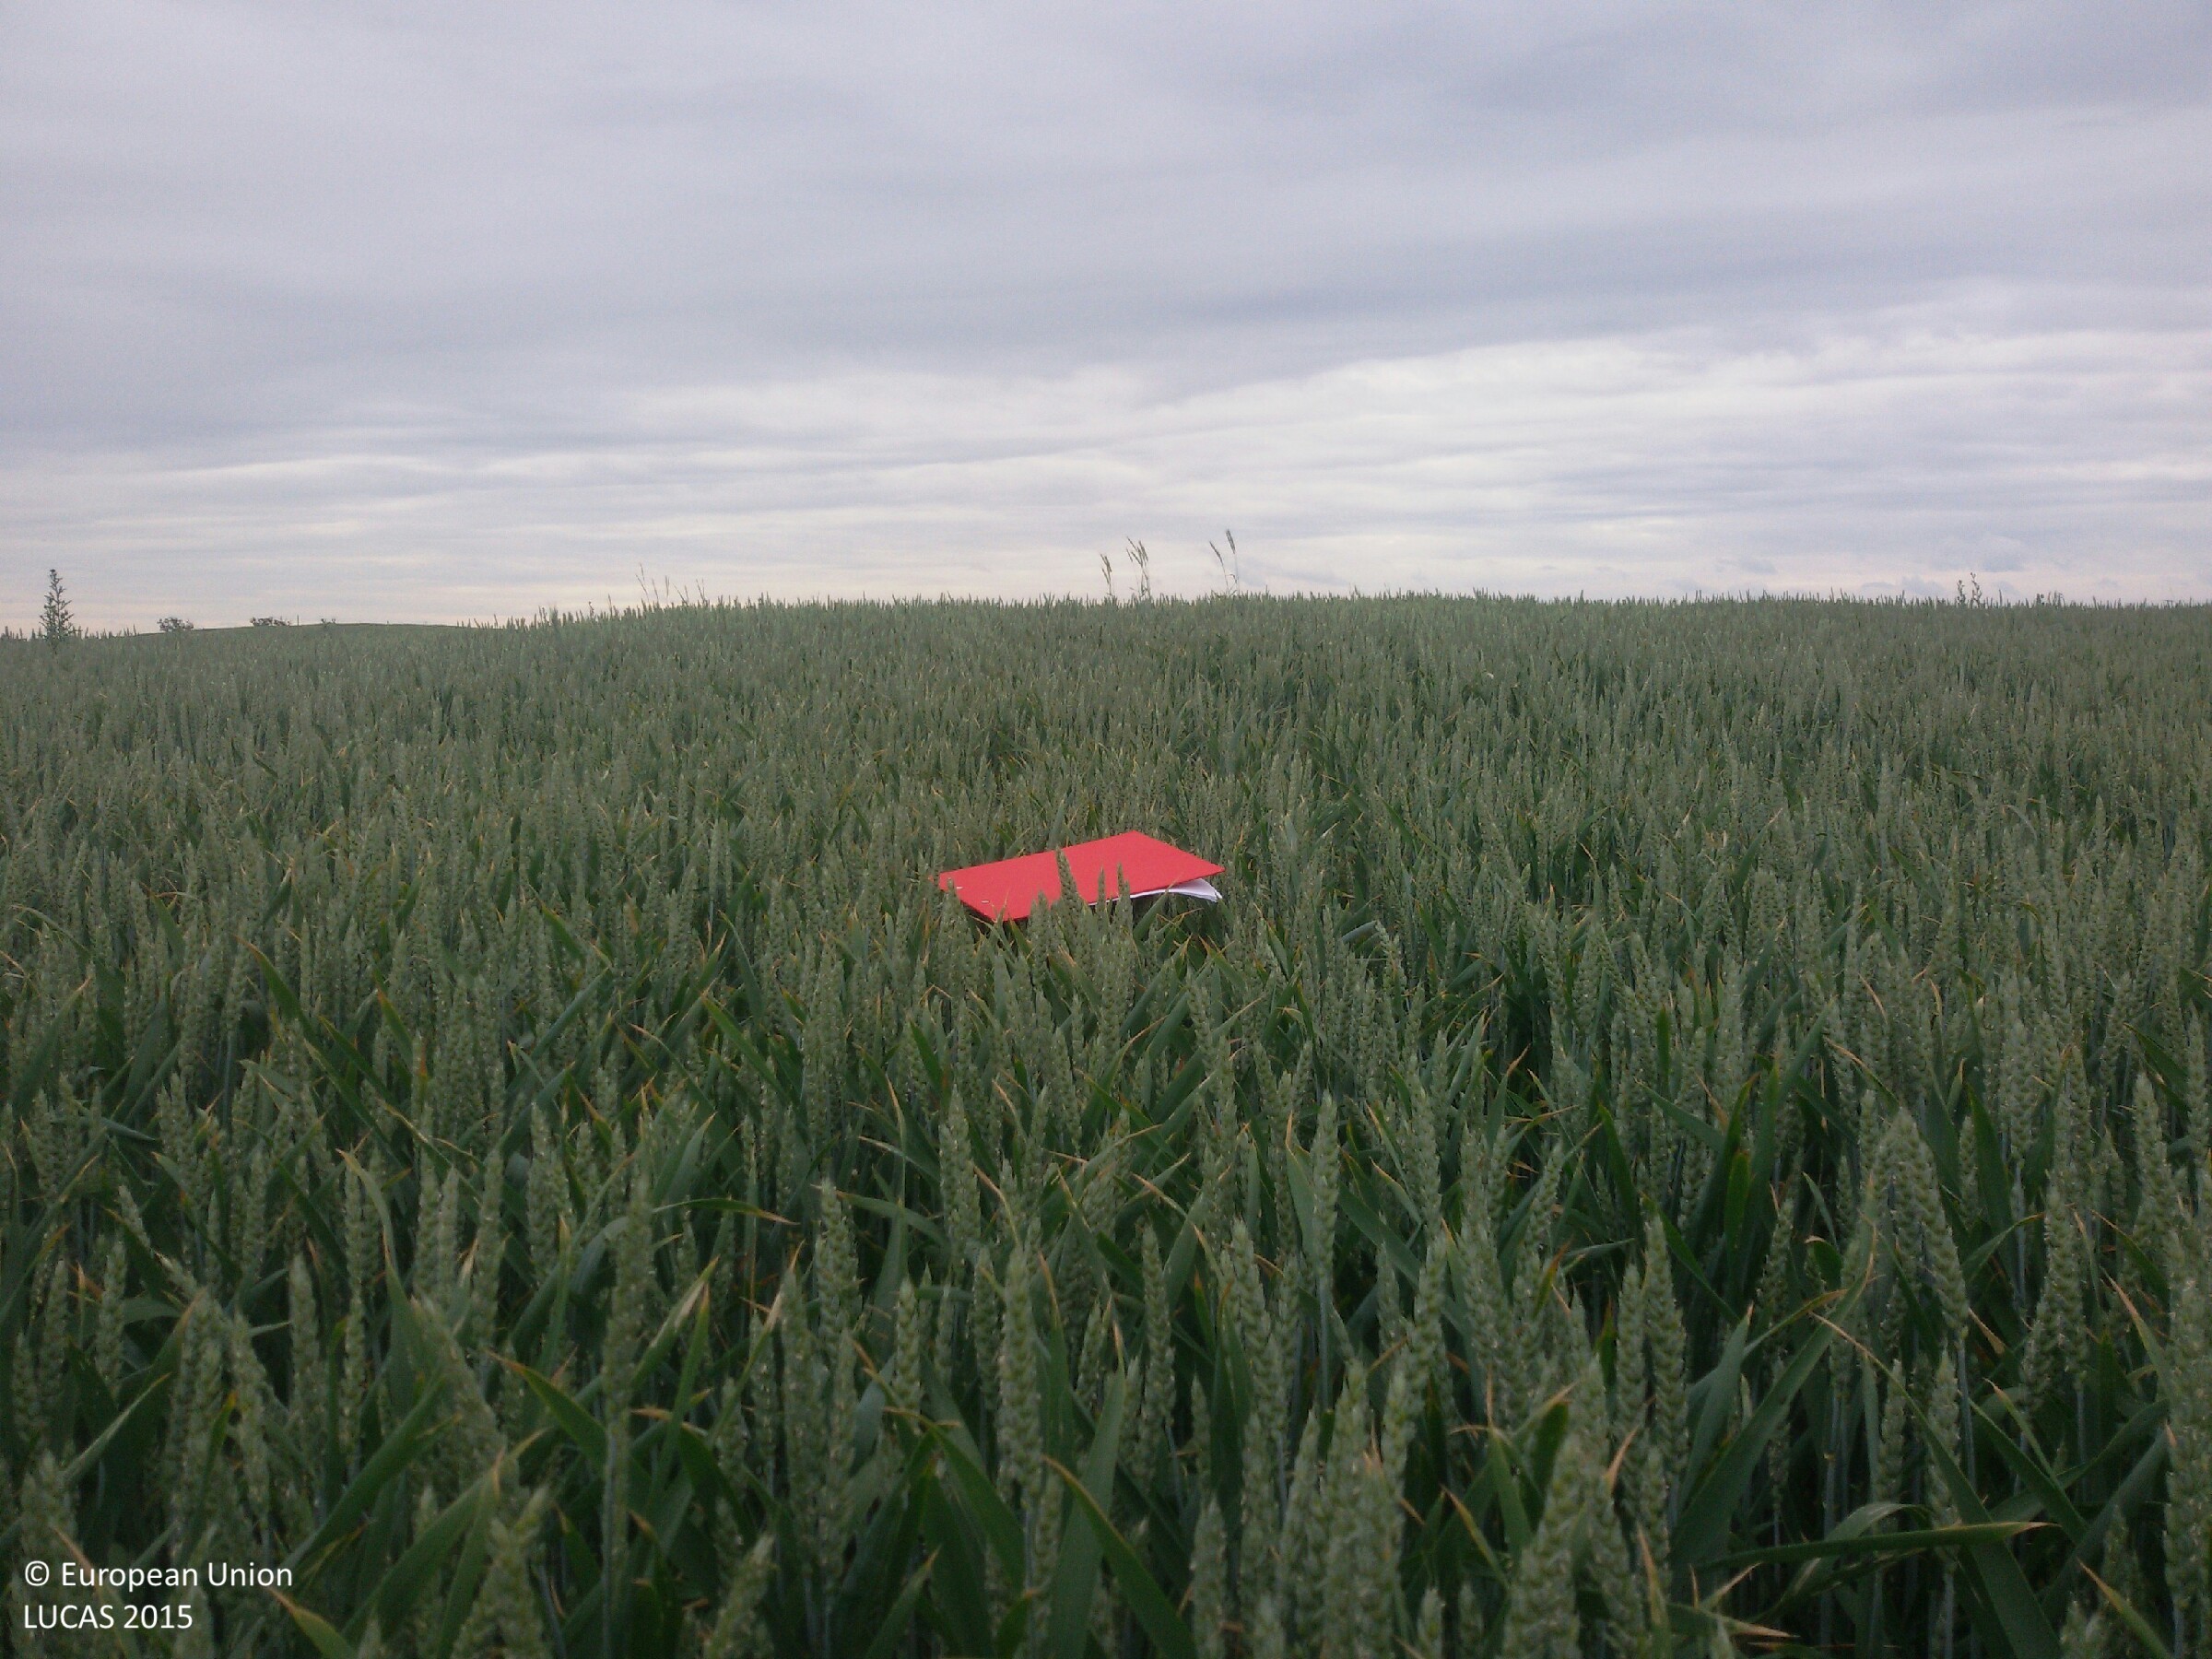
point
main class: Cropland
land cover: Common wheat
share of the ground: > 75 %
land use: Agriculture (excluding fallow land and kitchen gardens)
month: June
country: PL
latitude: 53.5721
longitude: 19.2511
